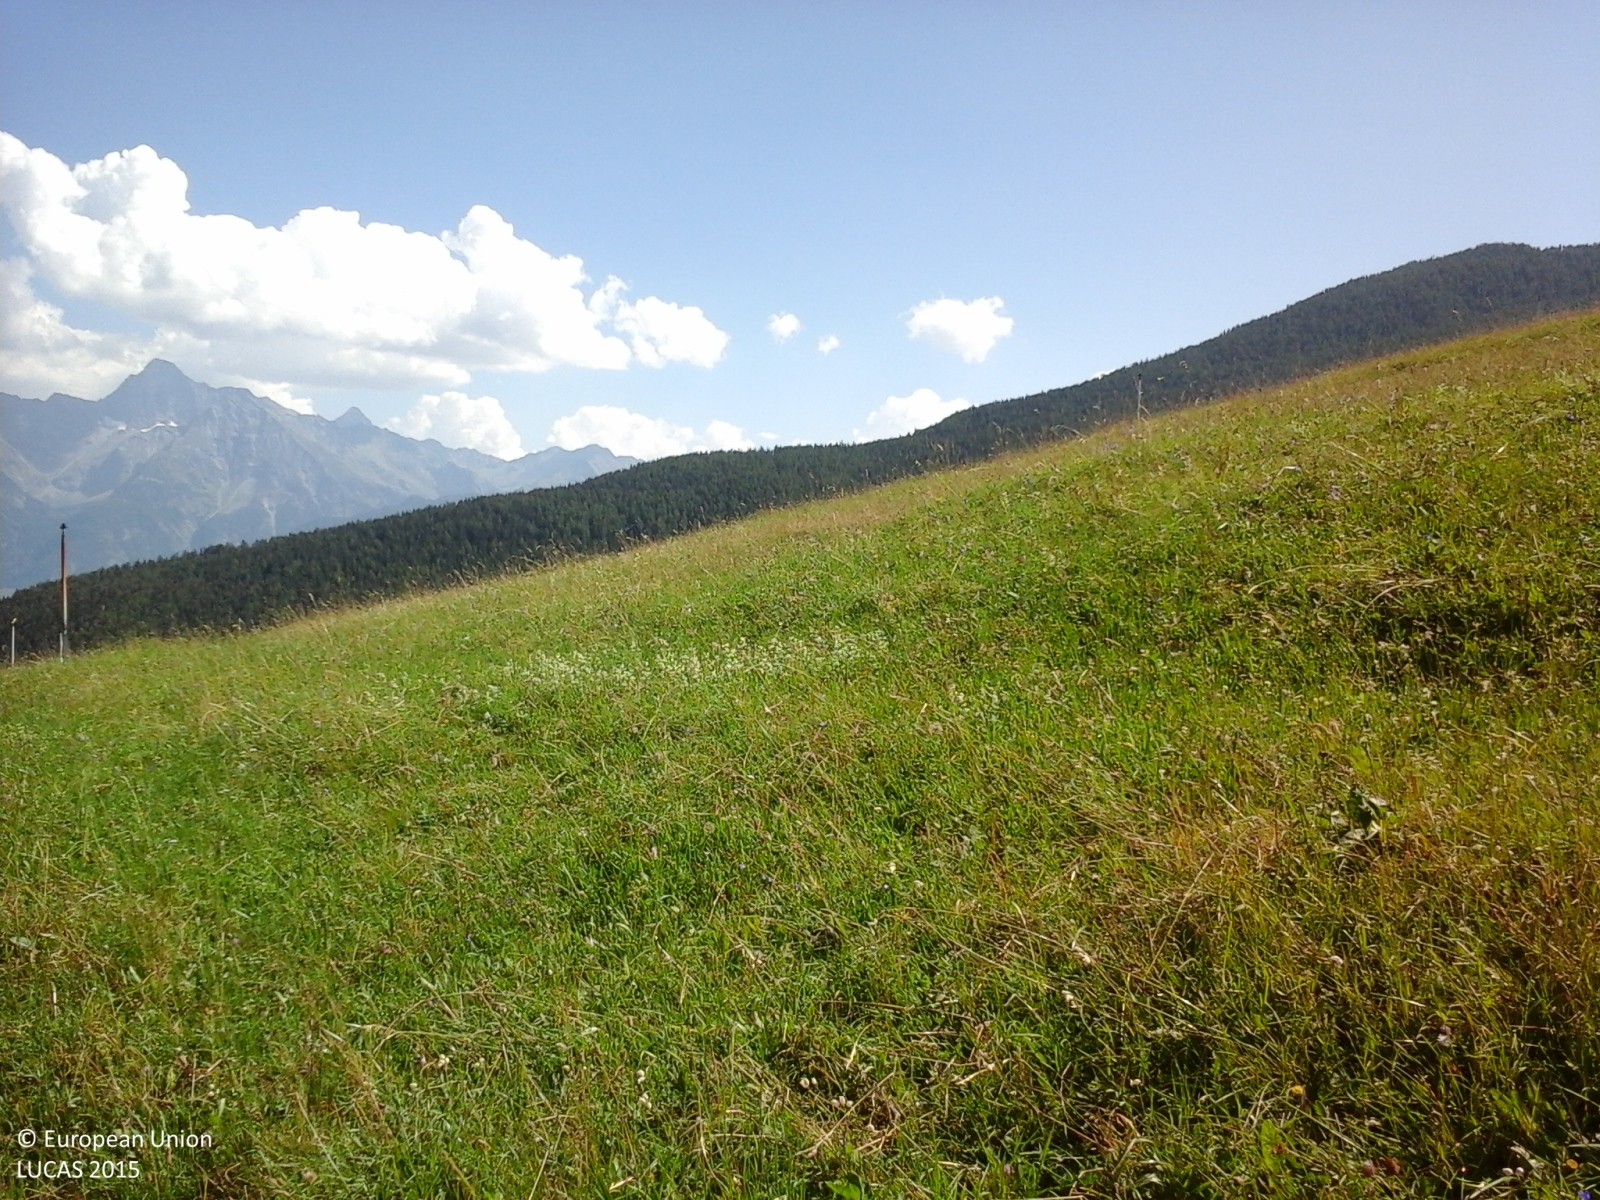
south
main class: Grassland
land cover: Grassland without tree/shrub cover
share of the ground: > 75 %
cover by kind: herbaceous plants 100 %
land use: Agriculture (excluding fallow land and kitchen gardens)
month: August
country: IT
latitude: 45.7935
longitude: 7.2635
